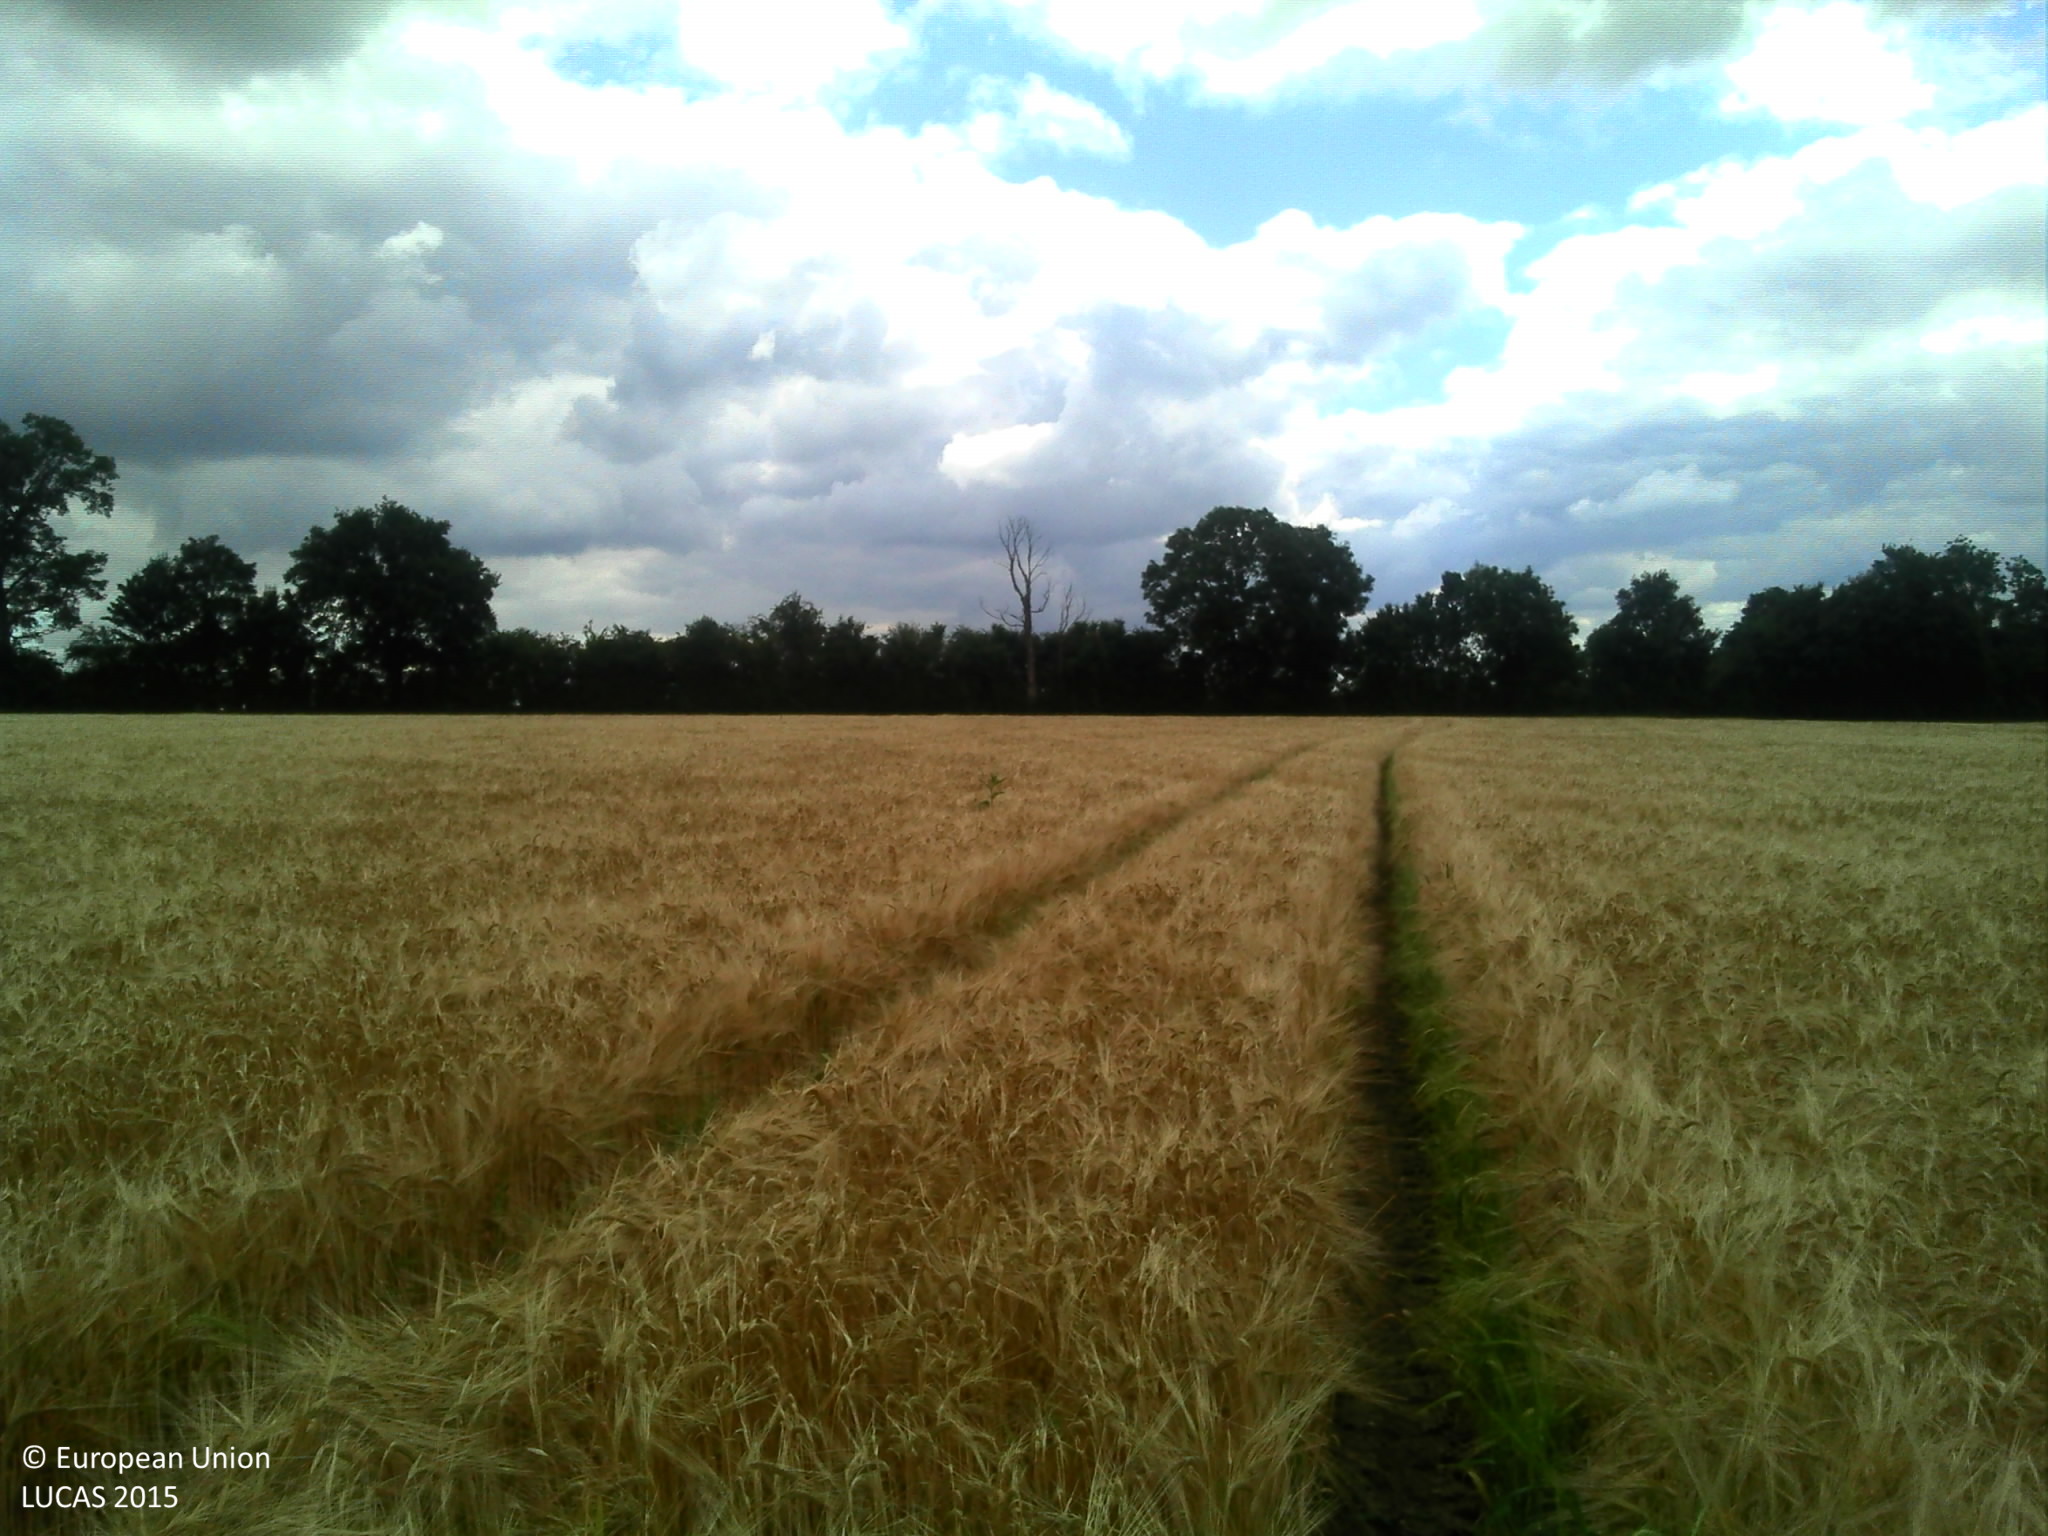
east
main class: Cropland
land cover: Barley
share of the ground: > 75 %
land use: Agriculture (excluding fallow land and kitchen gardens)
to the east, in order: Barley; Grass margins; Managed hedges; Grass margins; Common wheat
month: June
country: FR
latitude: 48.7068
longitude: -0.2380
